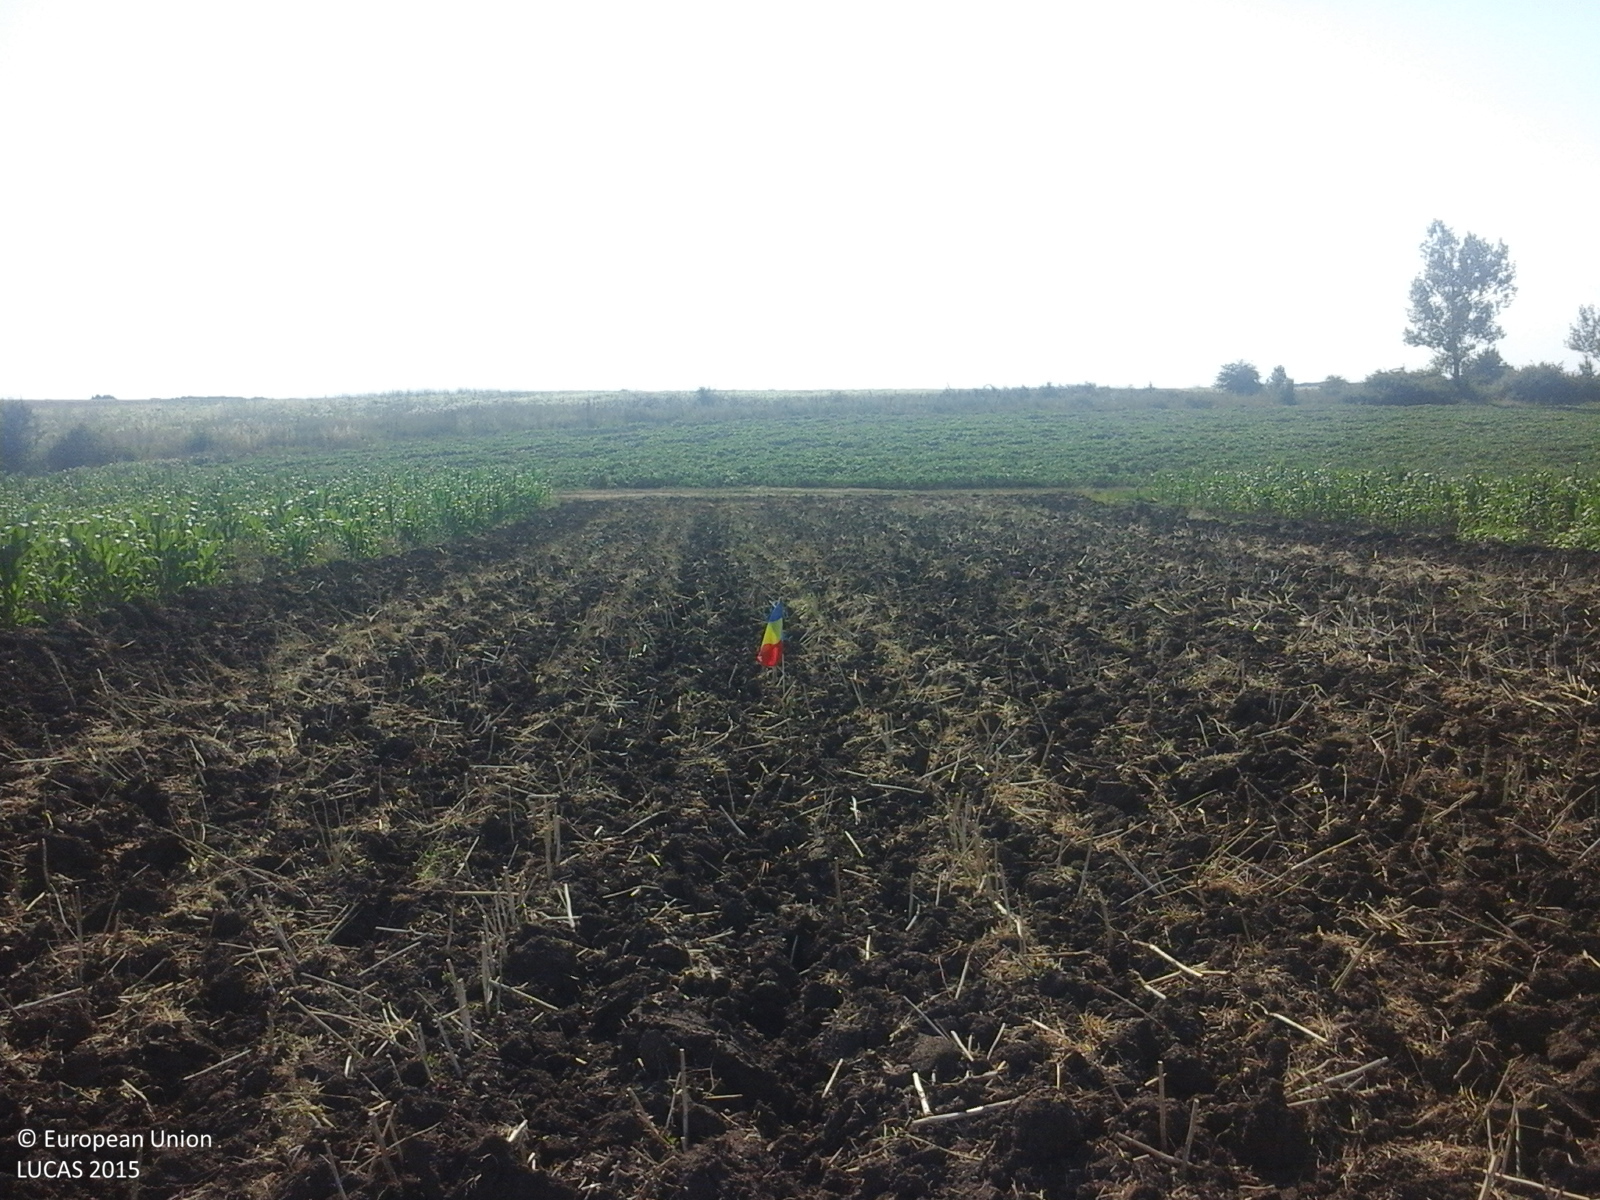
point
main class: Cropland
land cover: Rape and turnip rape
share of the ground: < 10 %
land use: Agriculture (excluding fallow land and kitchen gardens)
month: July
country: RO
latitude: 44.6173
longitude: 24.4246
